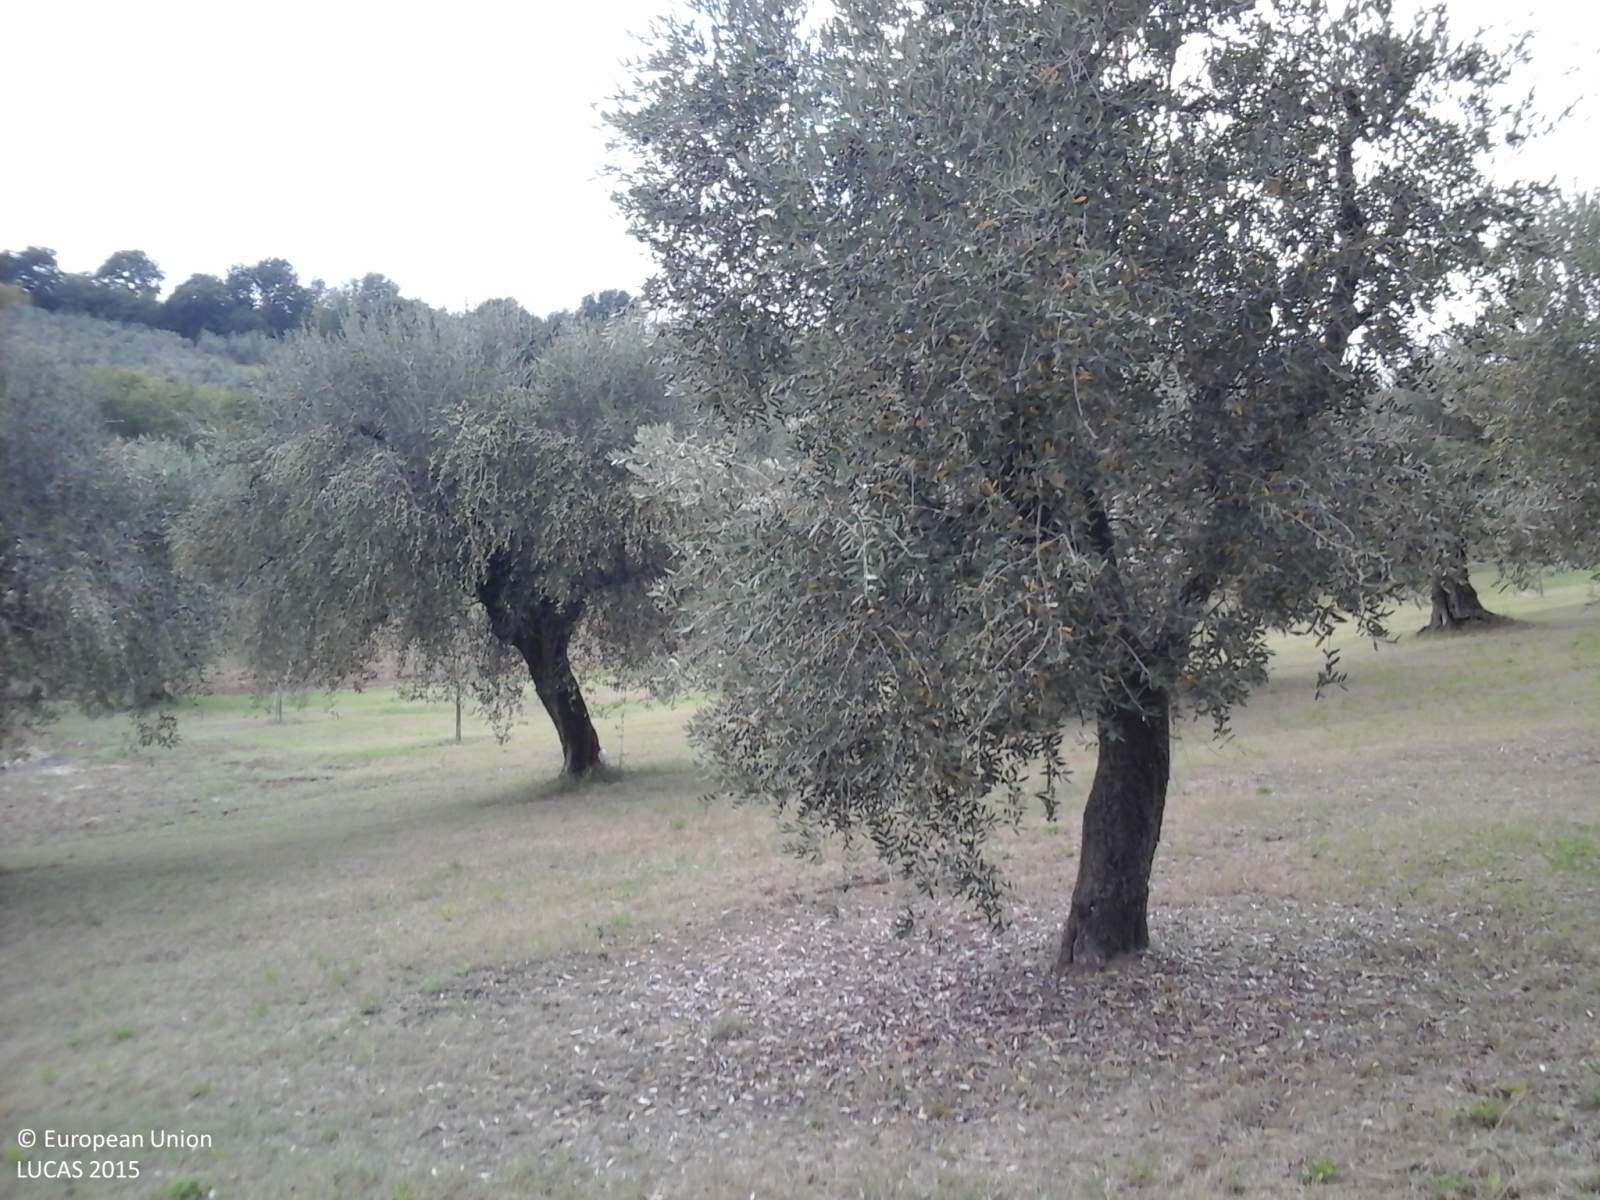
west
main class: Cropland
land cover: Olive groves
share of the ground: 25 - 50 %
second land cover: Grassland without tree/shrub cover
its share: > 75 %
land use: Agriculture (excluding fallow land and kitchen gardens)
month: October
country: IT
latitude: 43.6128
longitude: 13.2756
